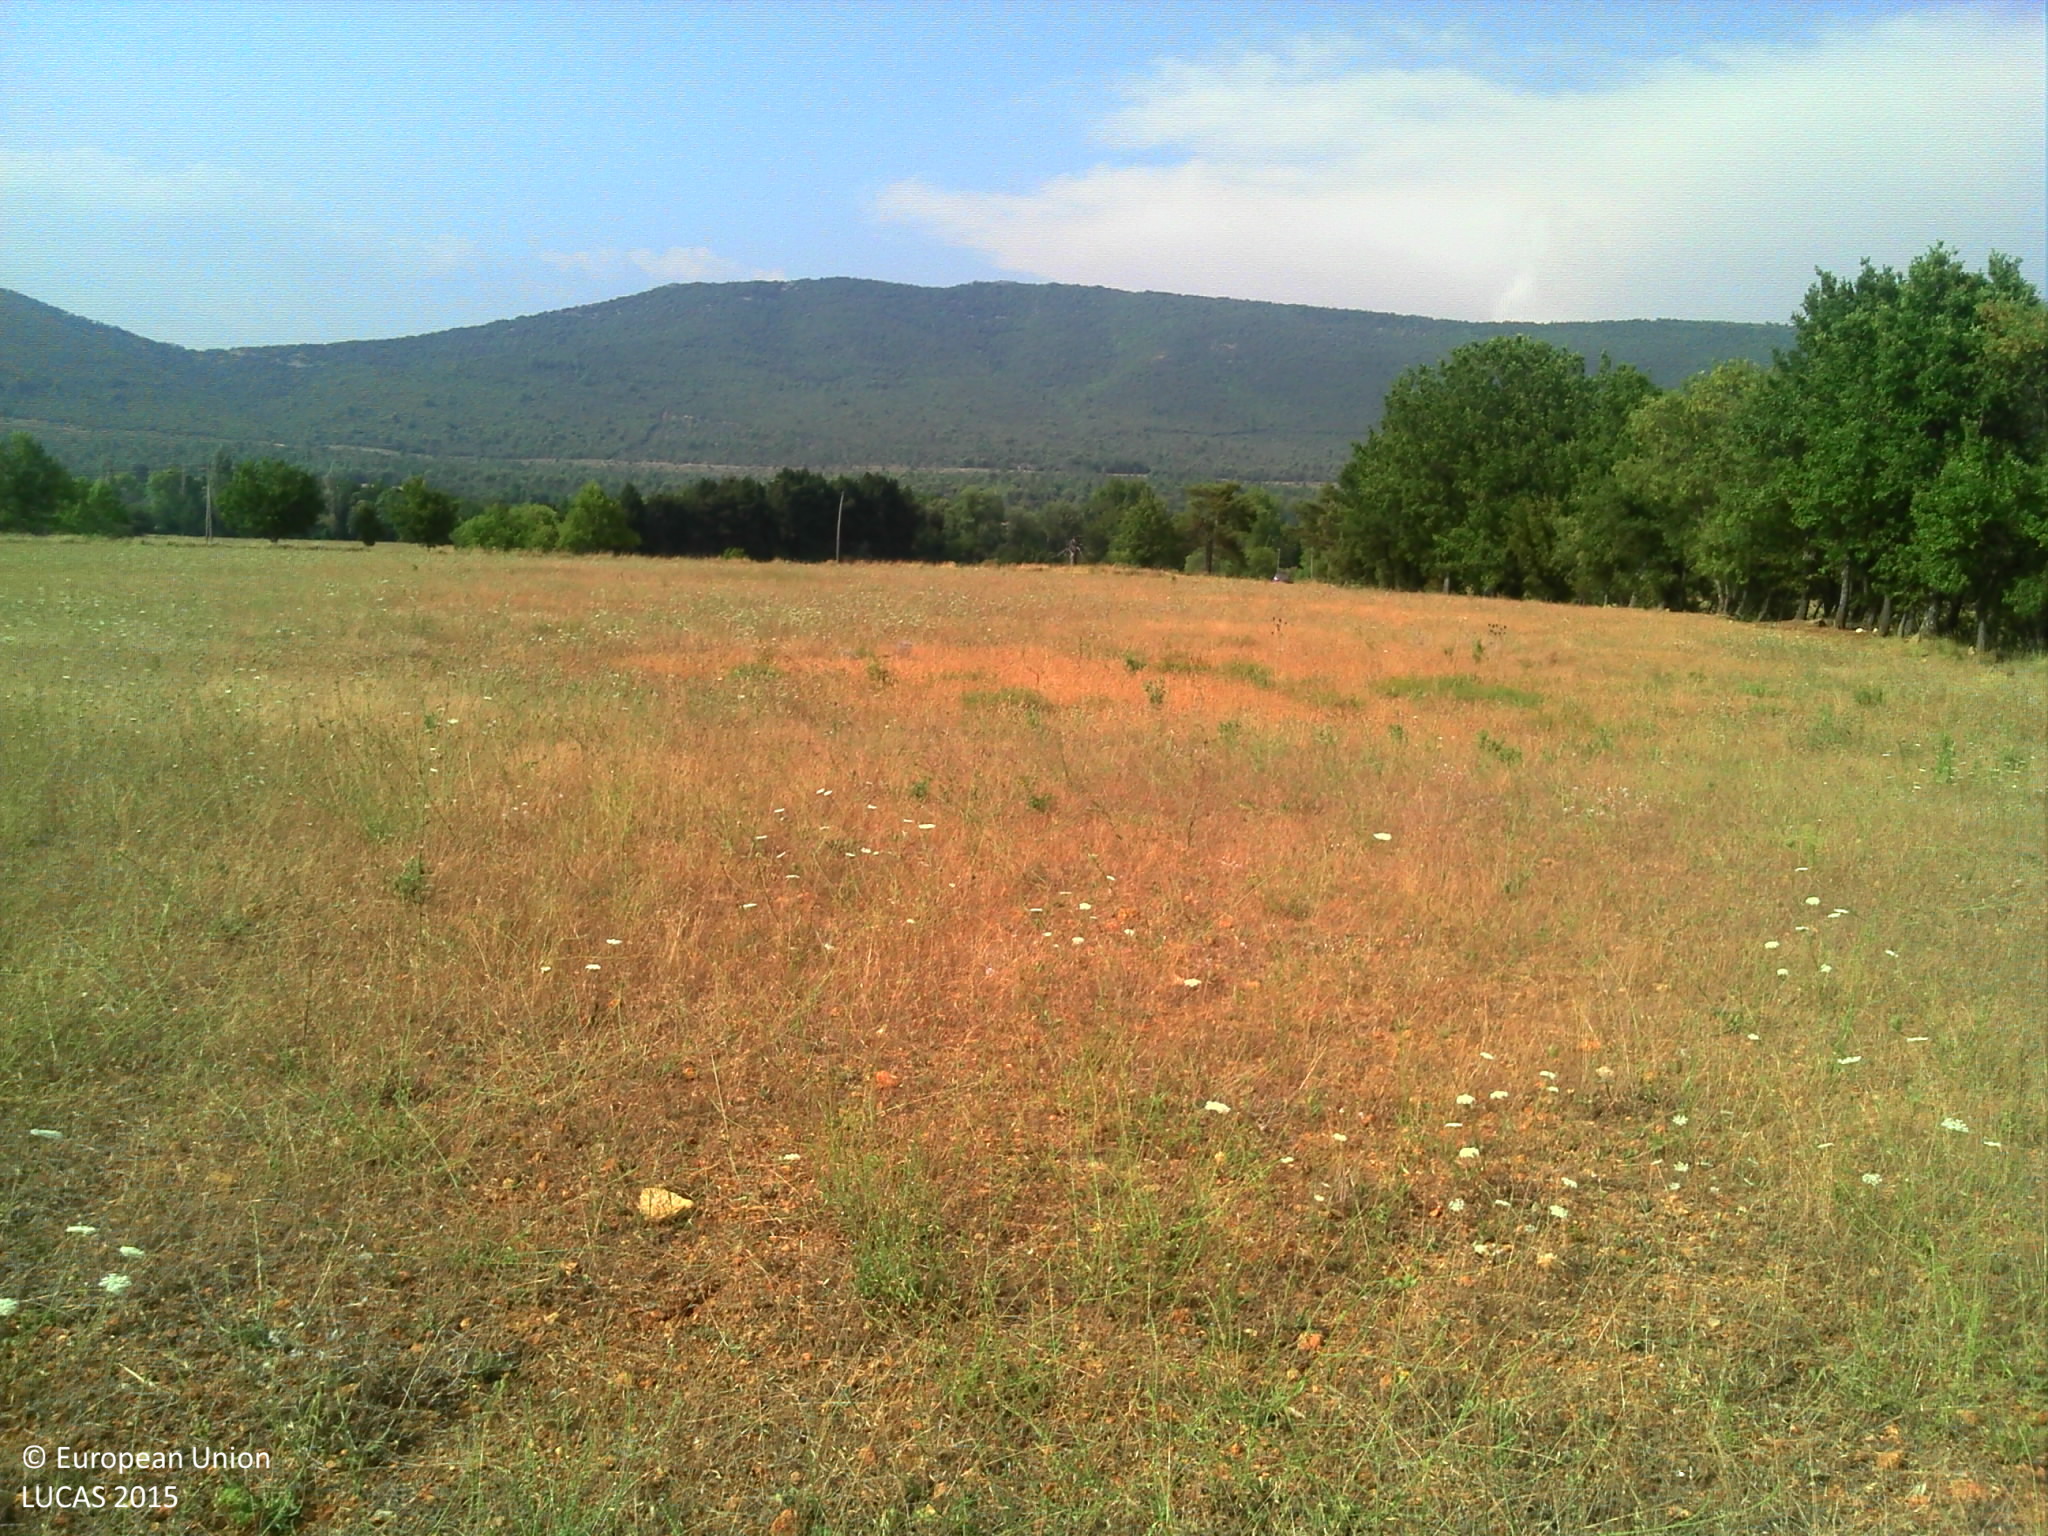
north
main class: Cropland
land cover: Temporary grasslands
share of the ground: > 75 %
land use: Agriculture (excluding fallow land and kitchen gardens)
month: August
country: FR
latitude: 43.6183
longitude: 6.3529
